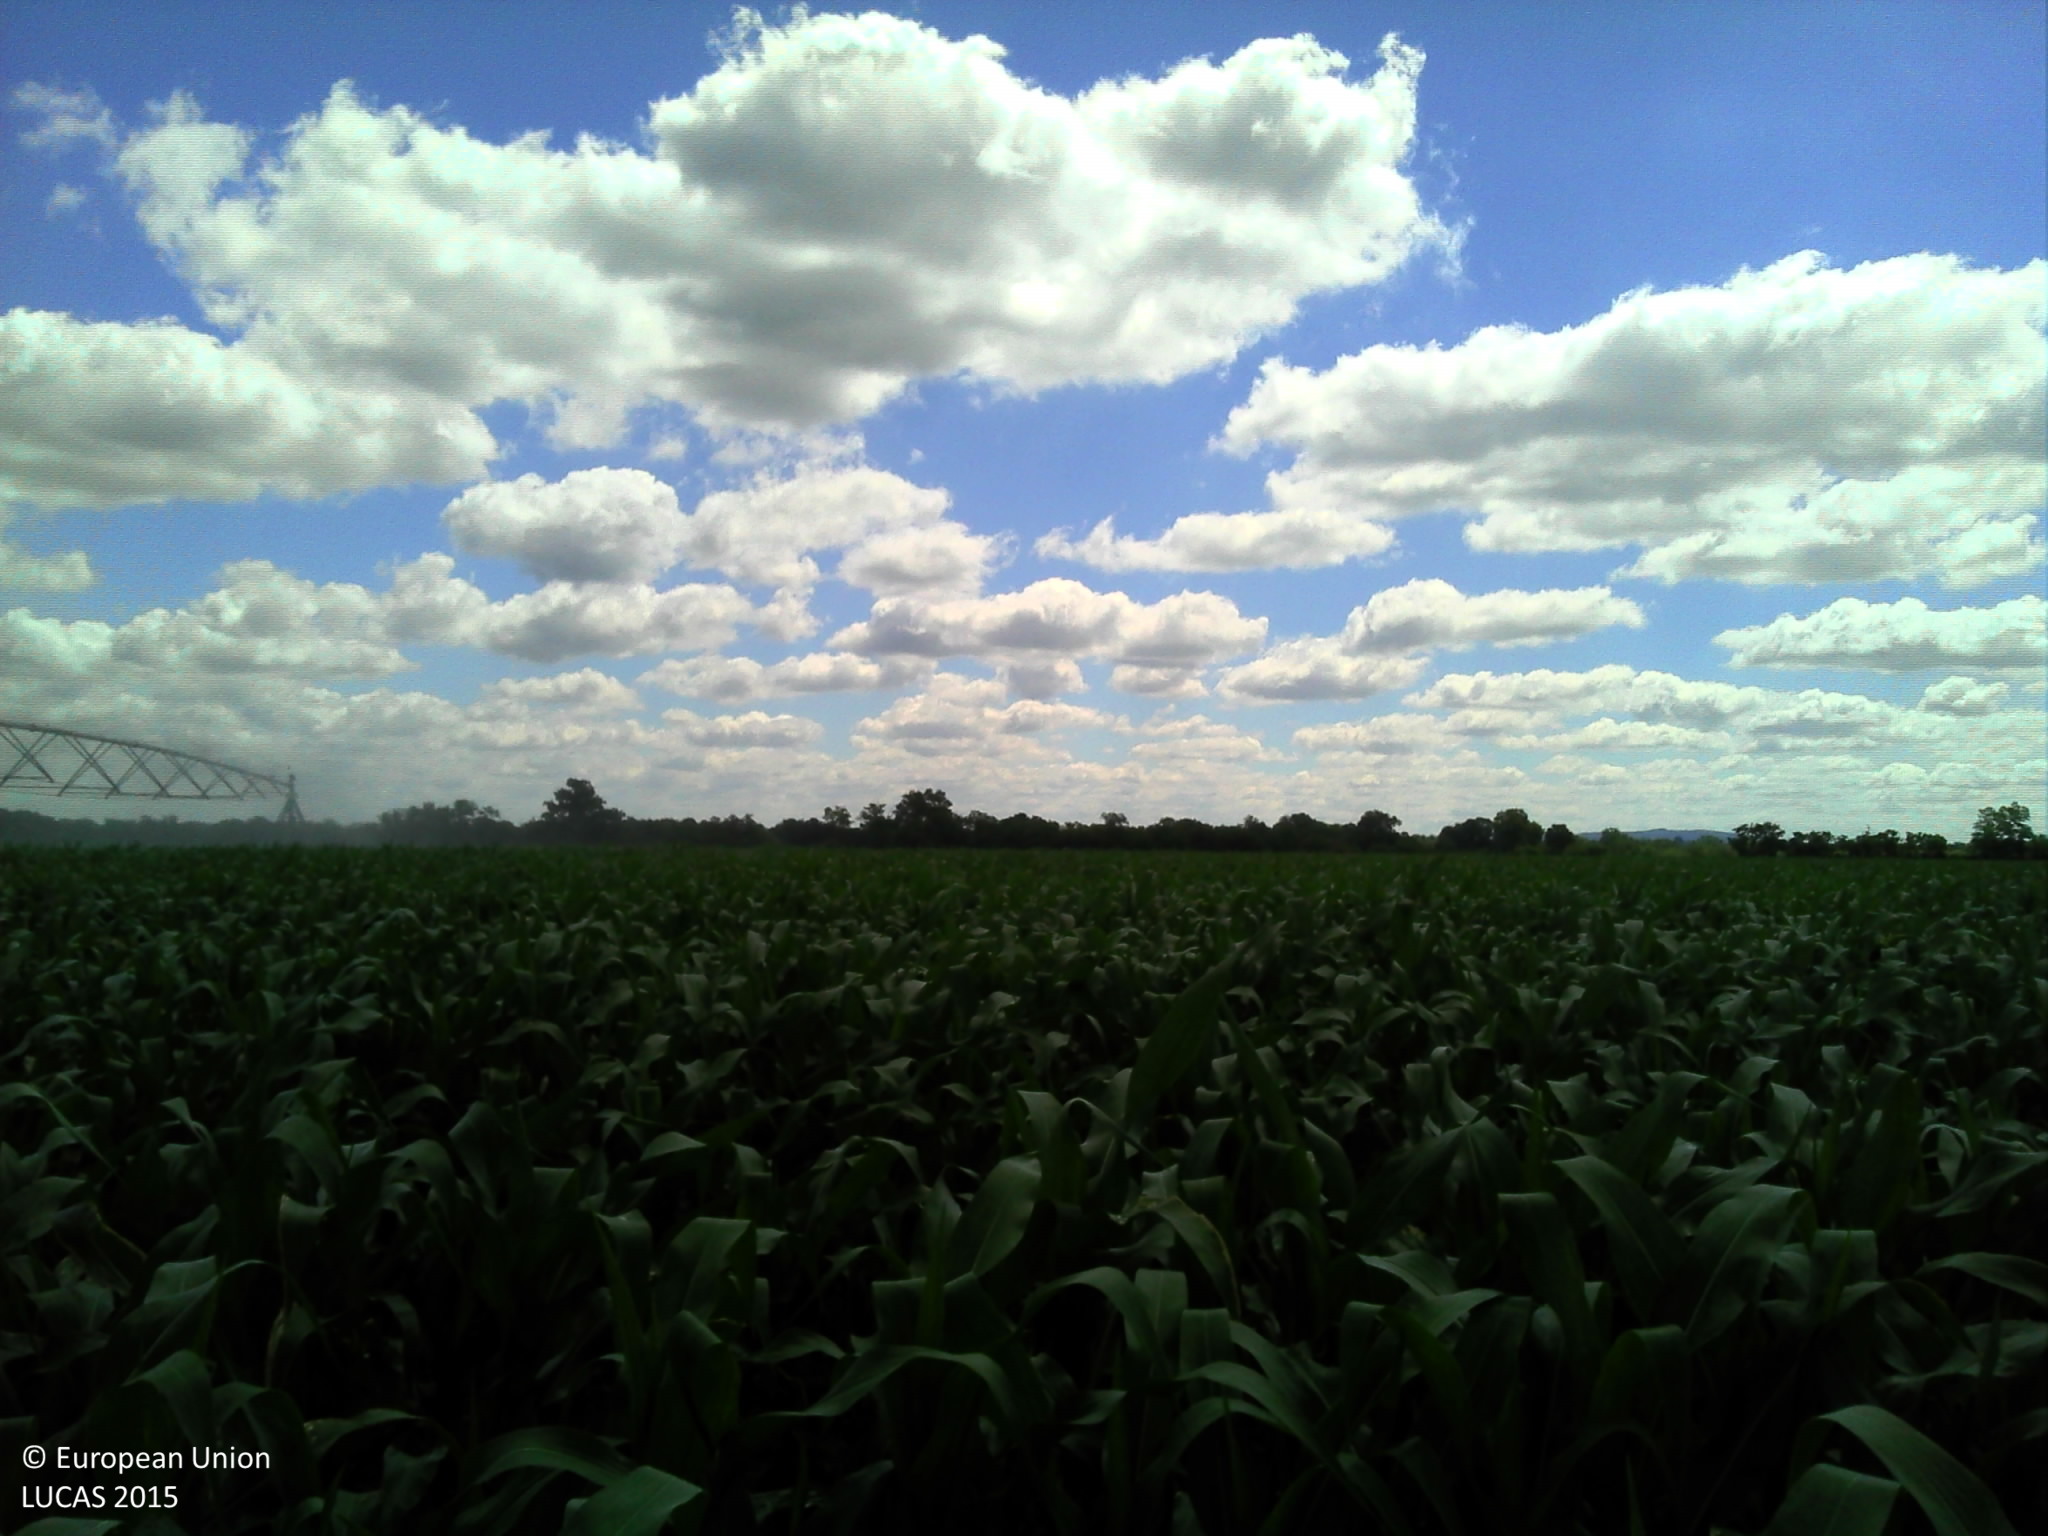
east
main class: Cropland
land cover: Maize
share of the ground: > 75 %
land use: Agriculture (excluding fallow land and kitchen gardens)
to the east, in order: Maize; Grassland without tree/shrub cover; Maize
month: June
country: FR
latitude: 46.7032
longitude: 3.6292
